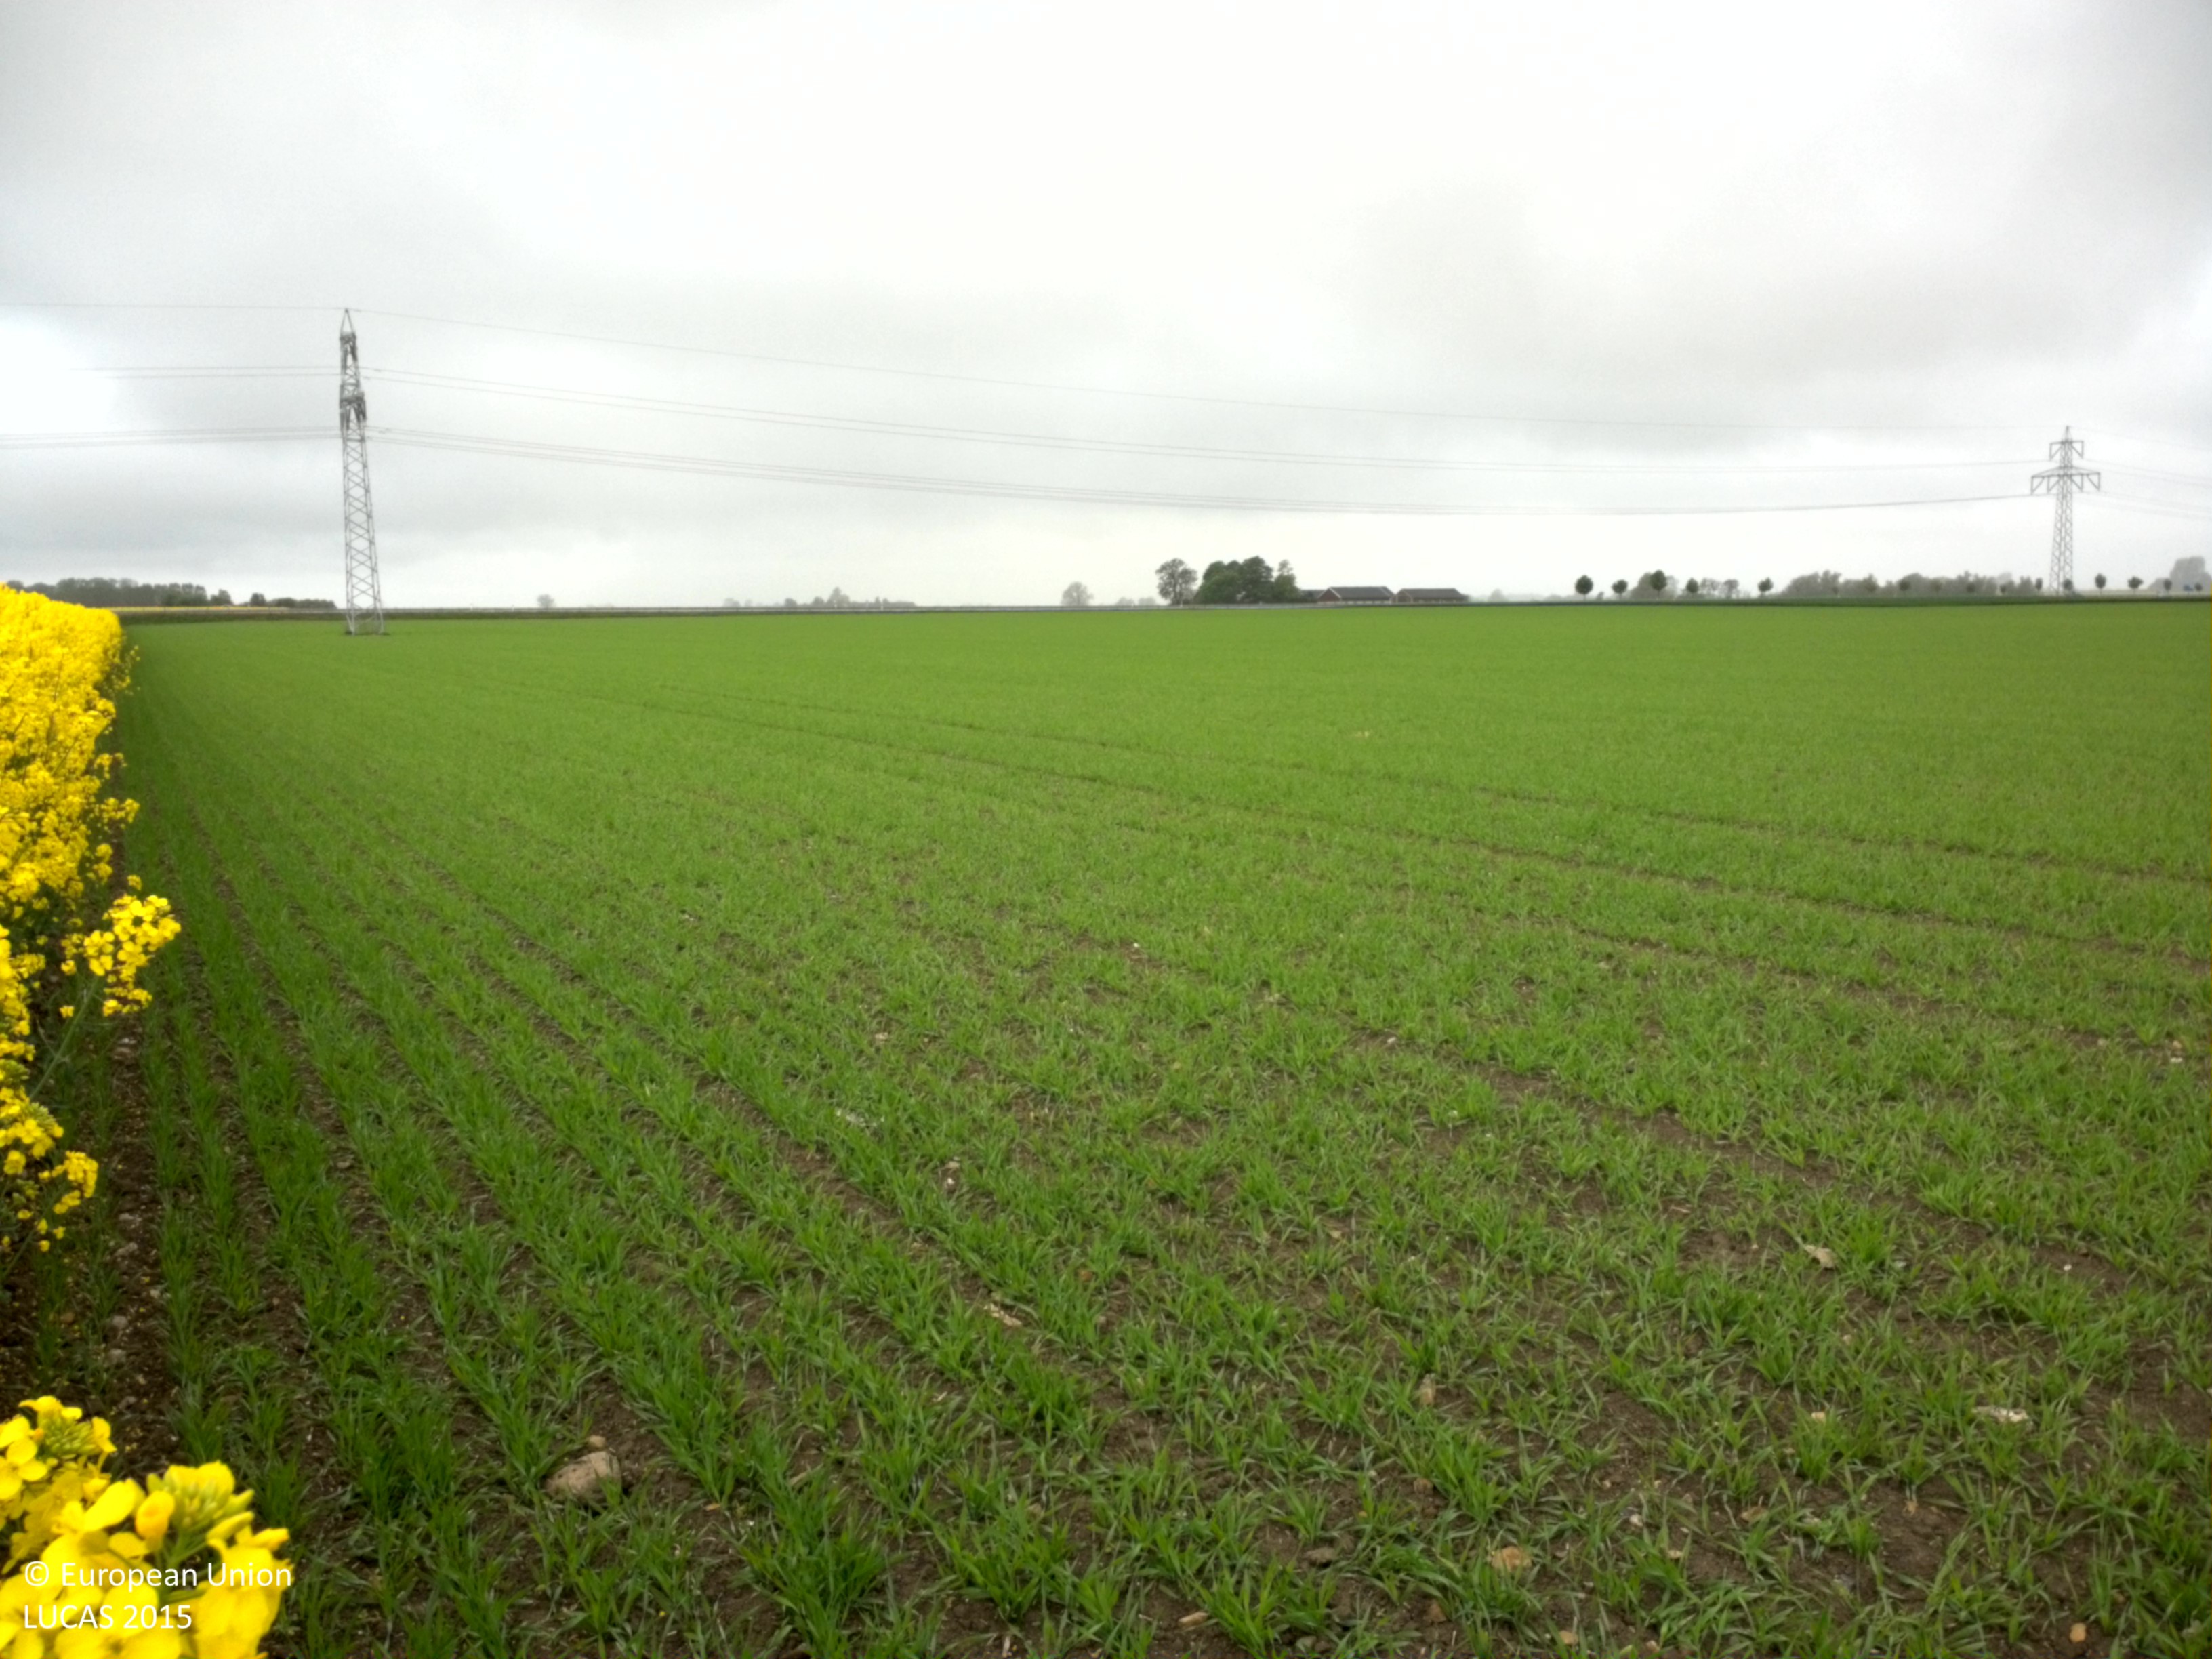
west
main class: Cropland
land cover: Rape and turnip rape
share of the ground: > 75 %
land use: Agriculture (excluding fallow land and kitchen gardens)
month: May
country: SE
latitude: 55.7537
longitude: 13.1367
